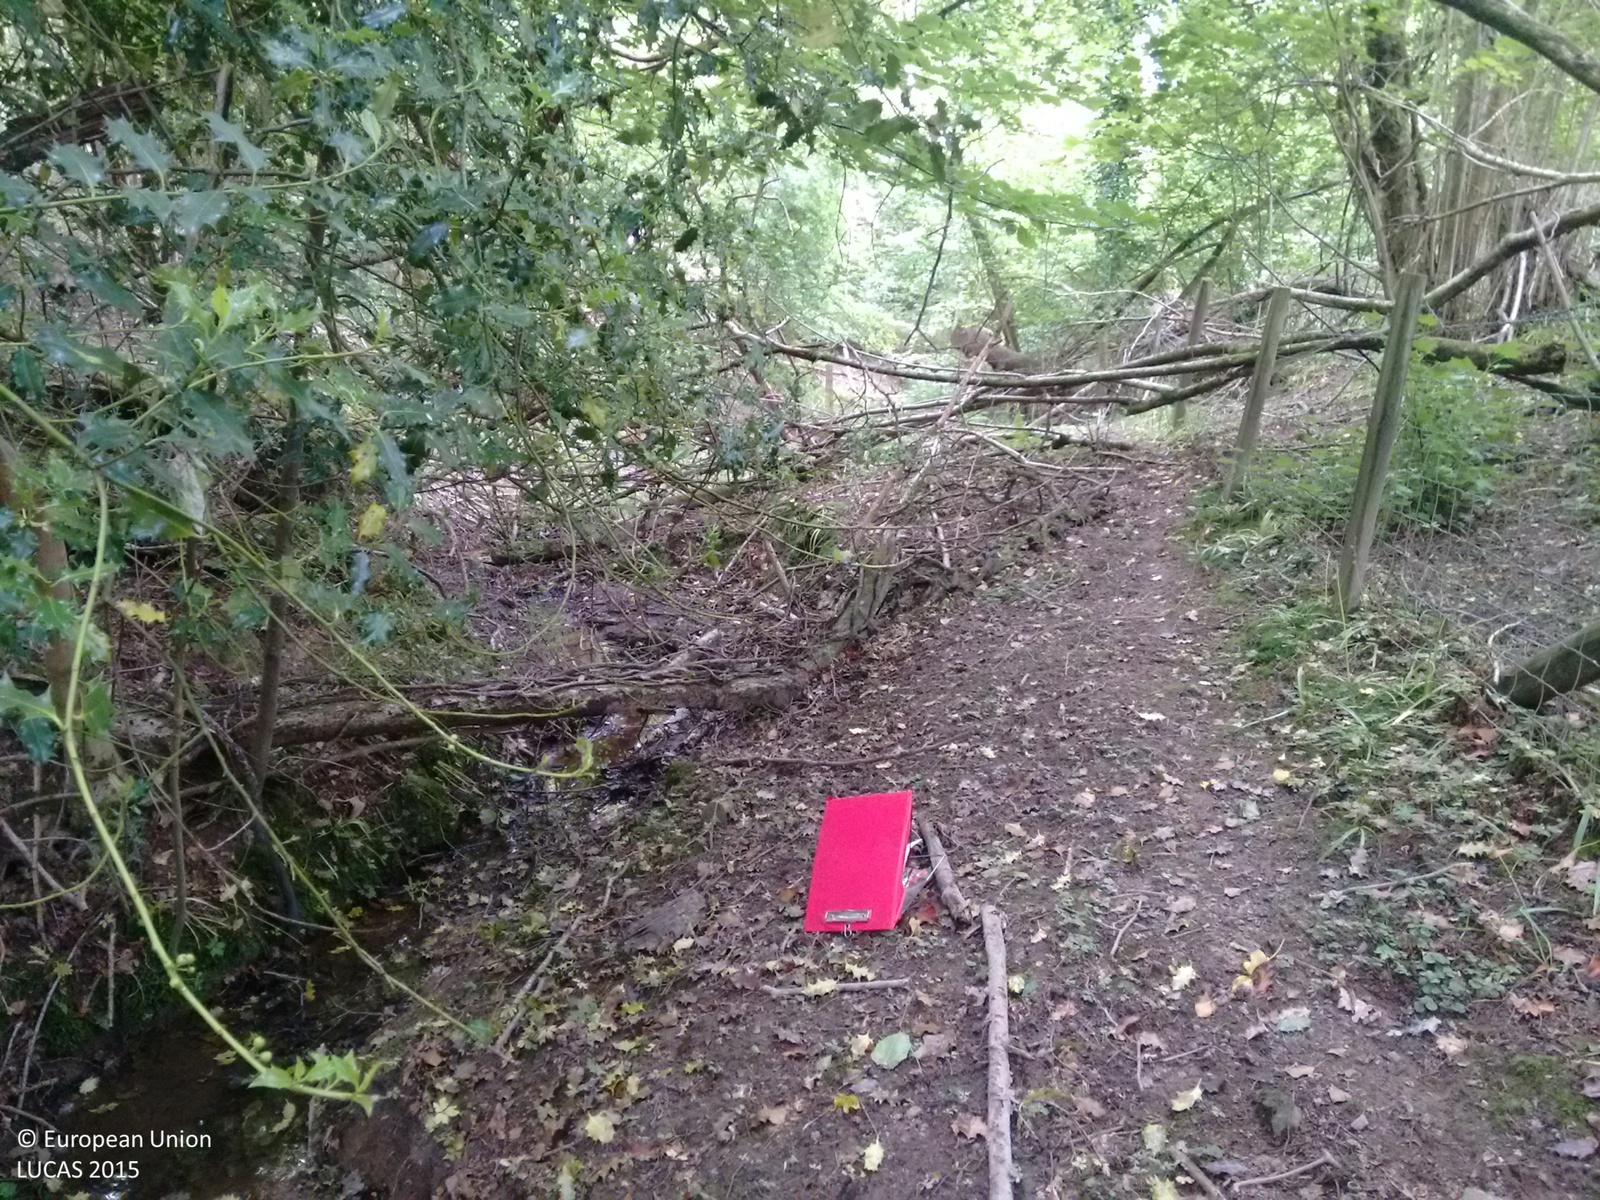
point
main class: Woodland
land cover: Broadleaved woodland
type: mesophytic deciduous forest
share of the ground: > 75 %
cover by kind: broadleaved forest trees 90 %, shrubs 10 %
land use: Forestry
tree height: > 5 m
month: June
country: GB
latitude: 50.9913
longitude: 0.1814
